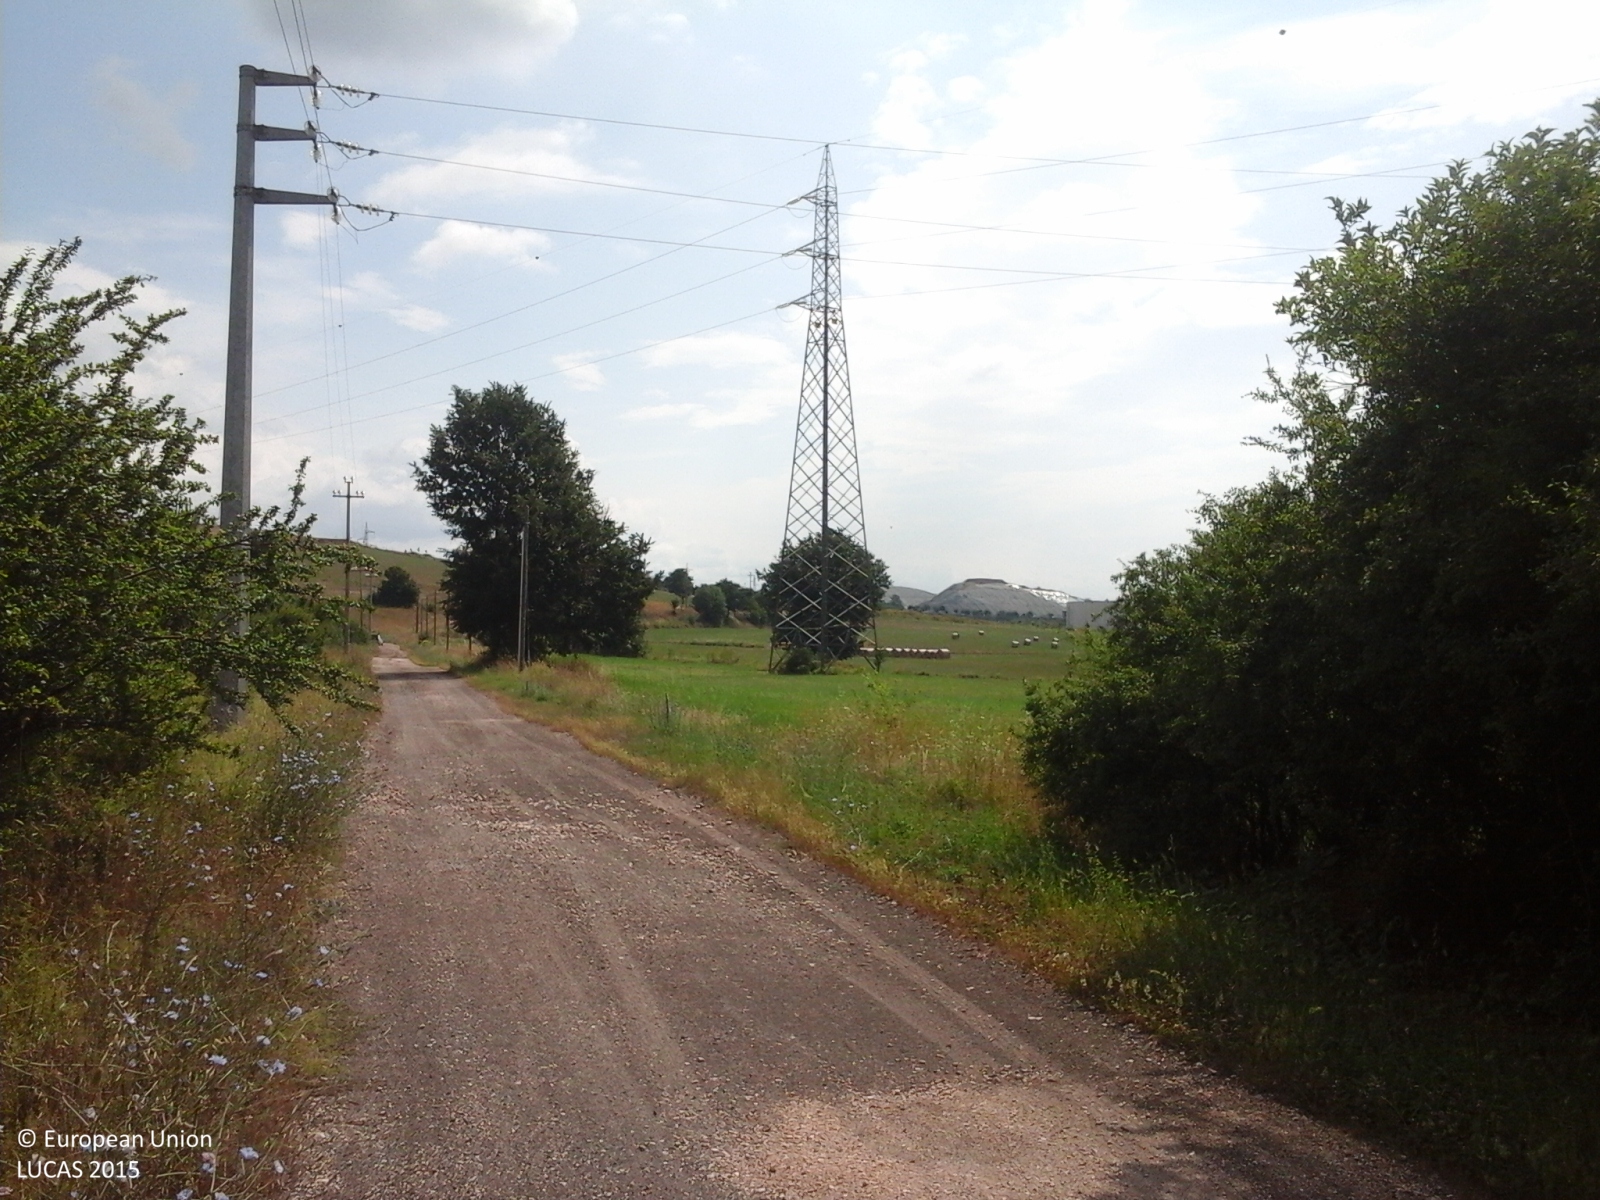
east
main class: Cropland
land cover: Temporary grasslands
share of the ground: > 75 %
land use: Agriculture (excluding fallow land and kitchen gardens)
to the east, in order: Temporary grasslands; Shrubland without tree cover; Temporary grasslands
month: June
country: IT
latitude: 41.7604
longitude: 12.9837
